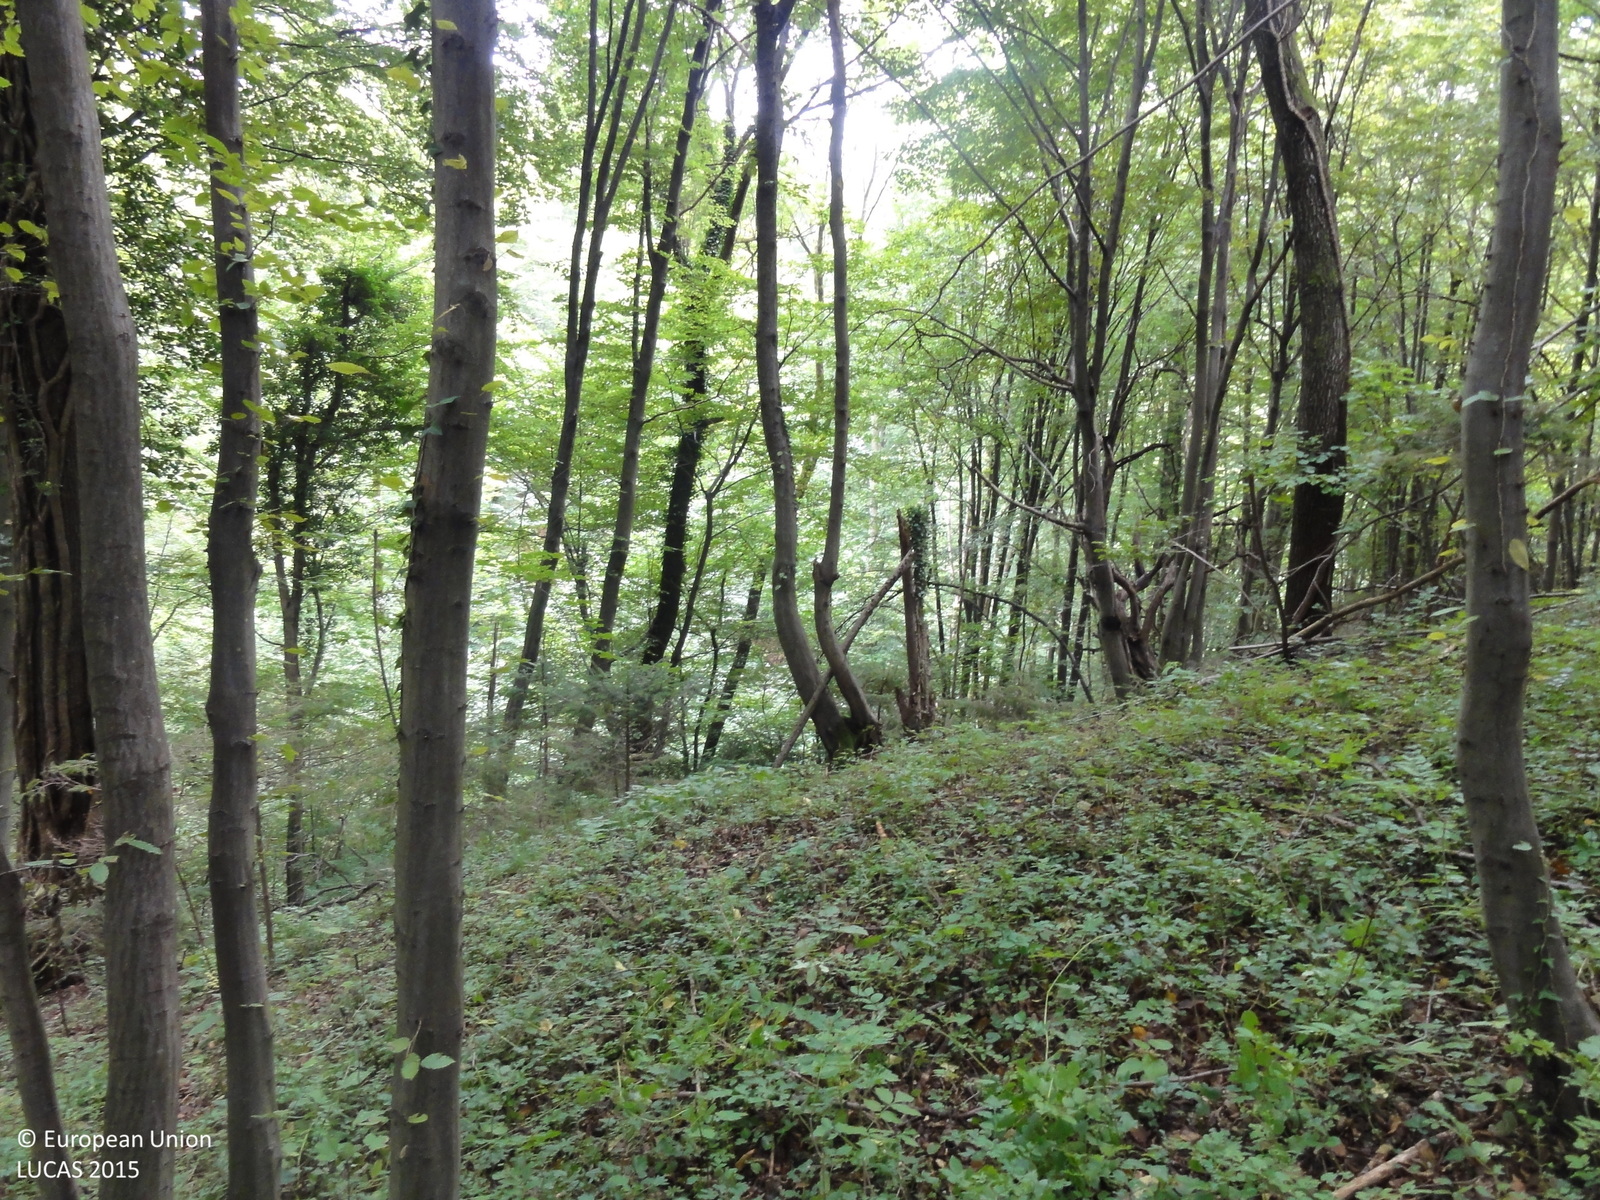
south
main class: Woodland
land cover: Broadleaved woodland
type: mesophytic deciduous forest
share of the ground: > 75 %
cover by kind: broadleaved forest trees 95 %, coniferous forest trees 5 %
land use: Forestry
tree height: > 5 m
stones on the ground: < 10 %
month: August
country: SI
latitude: 46.1605
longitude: 15.0347
